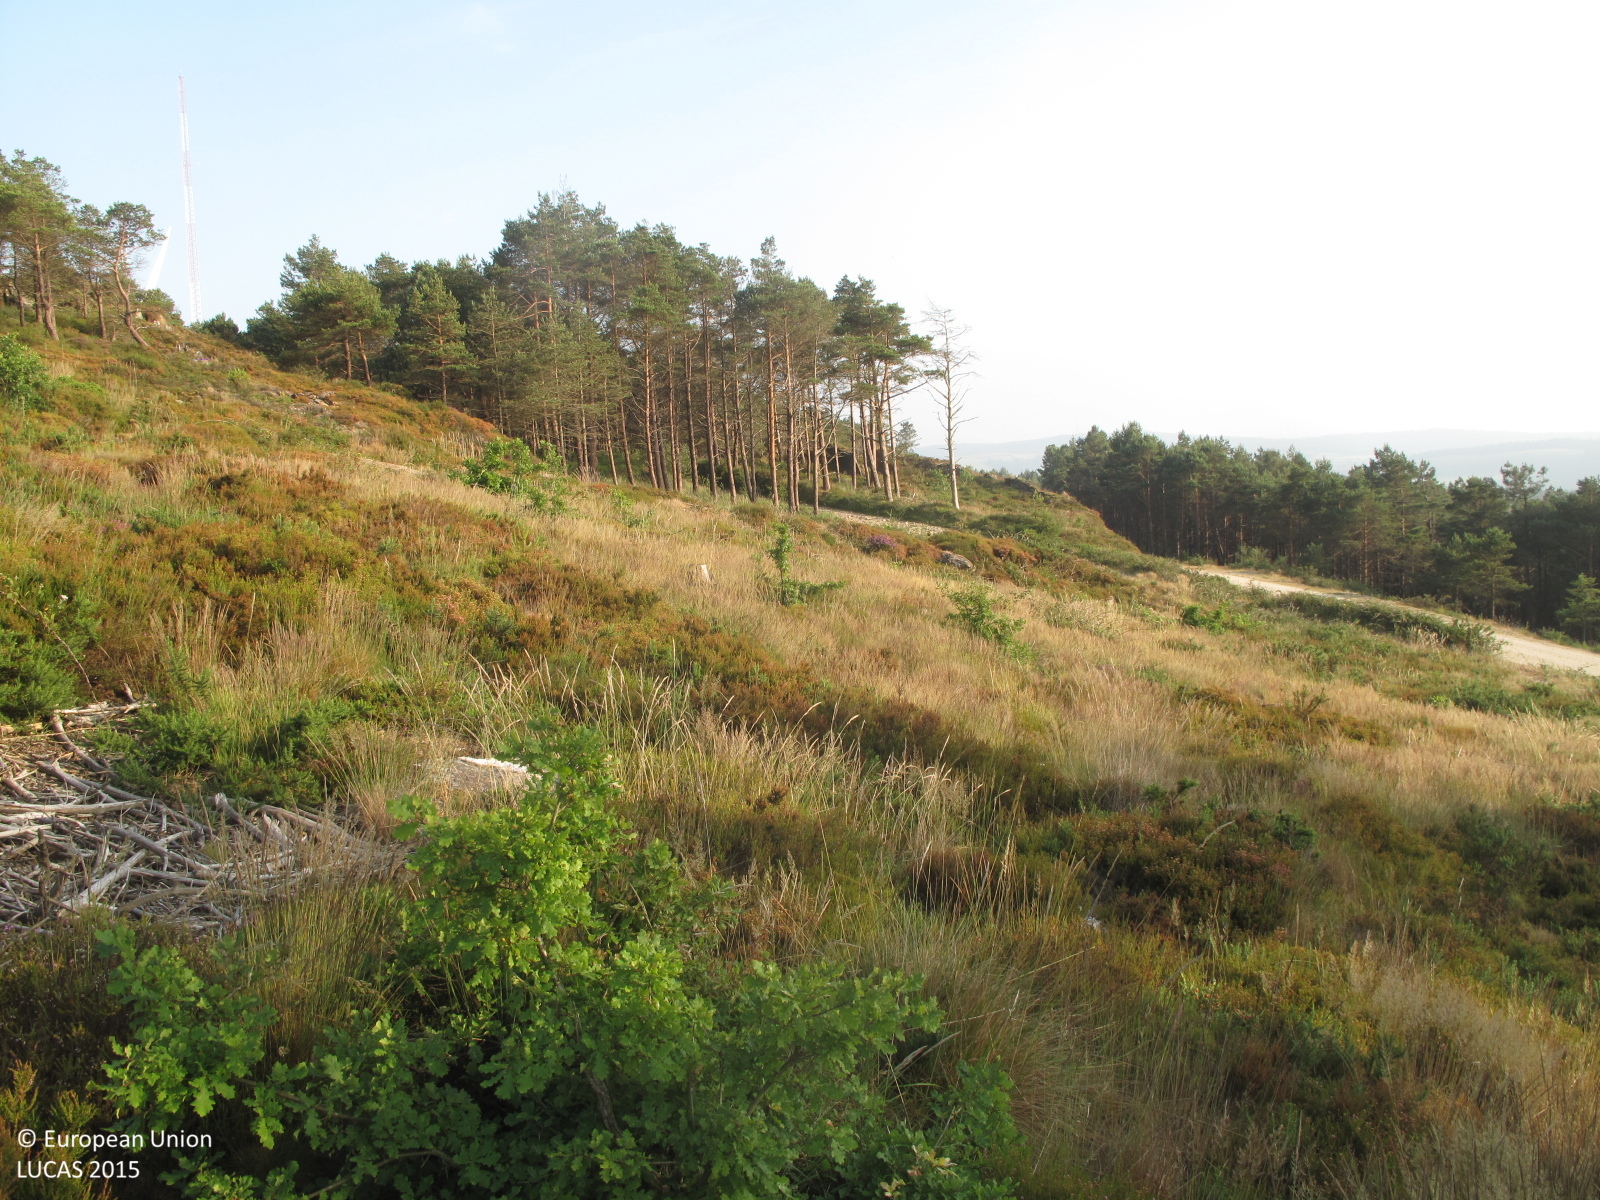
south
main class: Shrubland
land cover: Shrubland with sparse tree cover
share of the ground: 25 - 50 %
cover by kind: herbaceous plants 50 %, shrubs 45 %, broadleaved forest trees 5 %
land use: Semi-natural and natural areas not in use
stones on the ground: 10 - 25 %
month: June
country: ES
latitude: 43.0896
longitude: -7.9134
